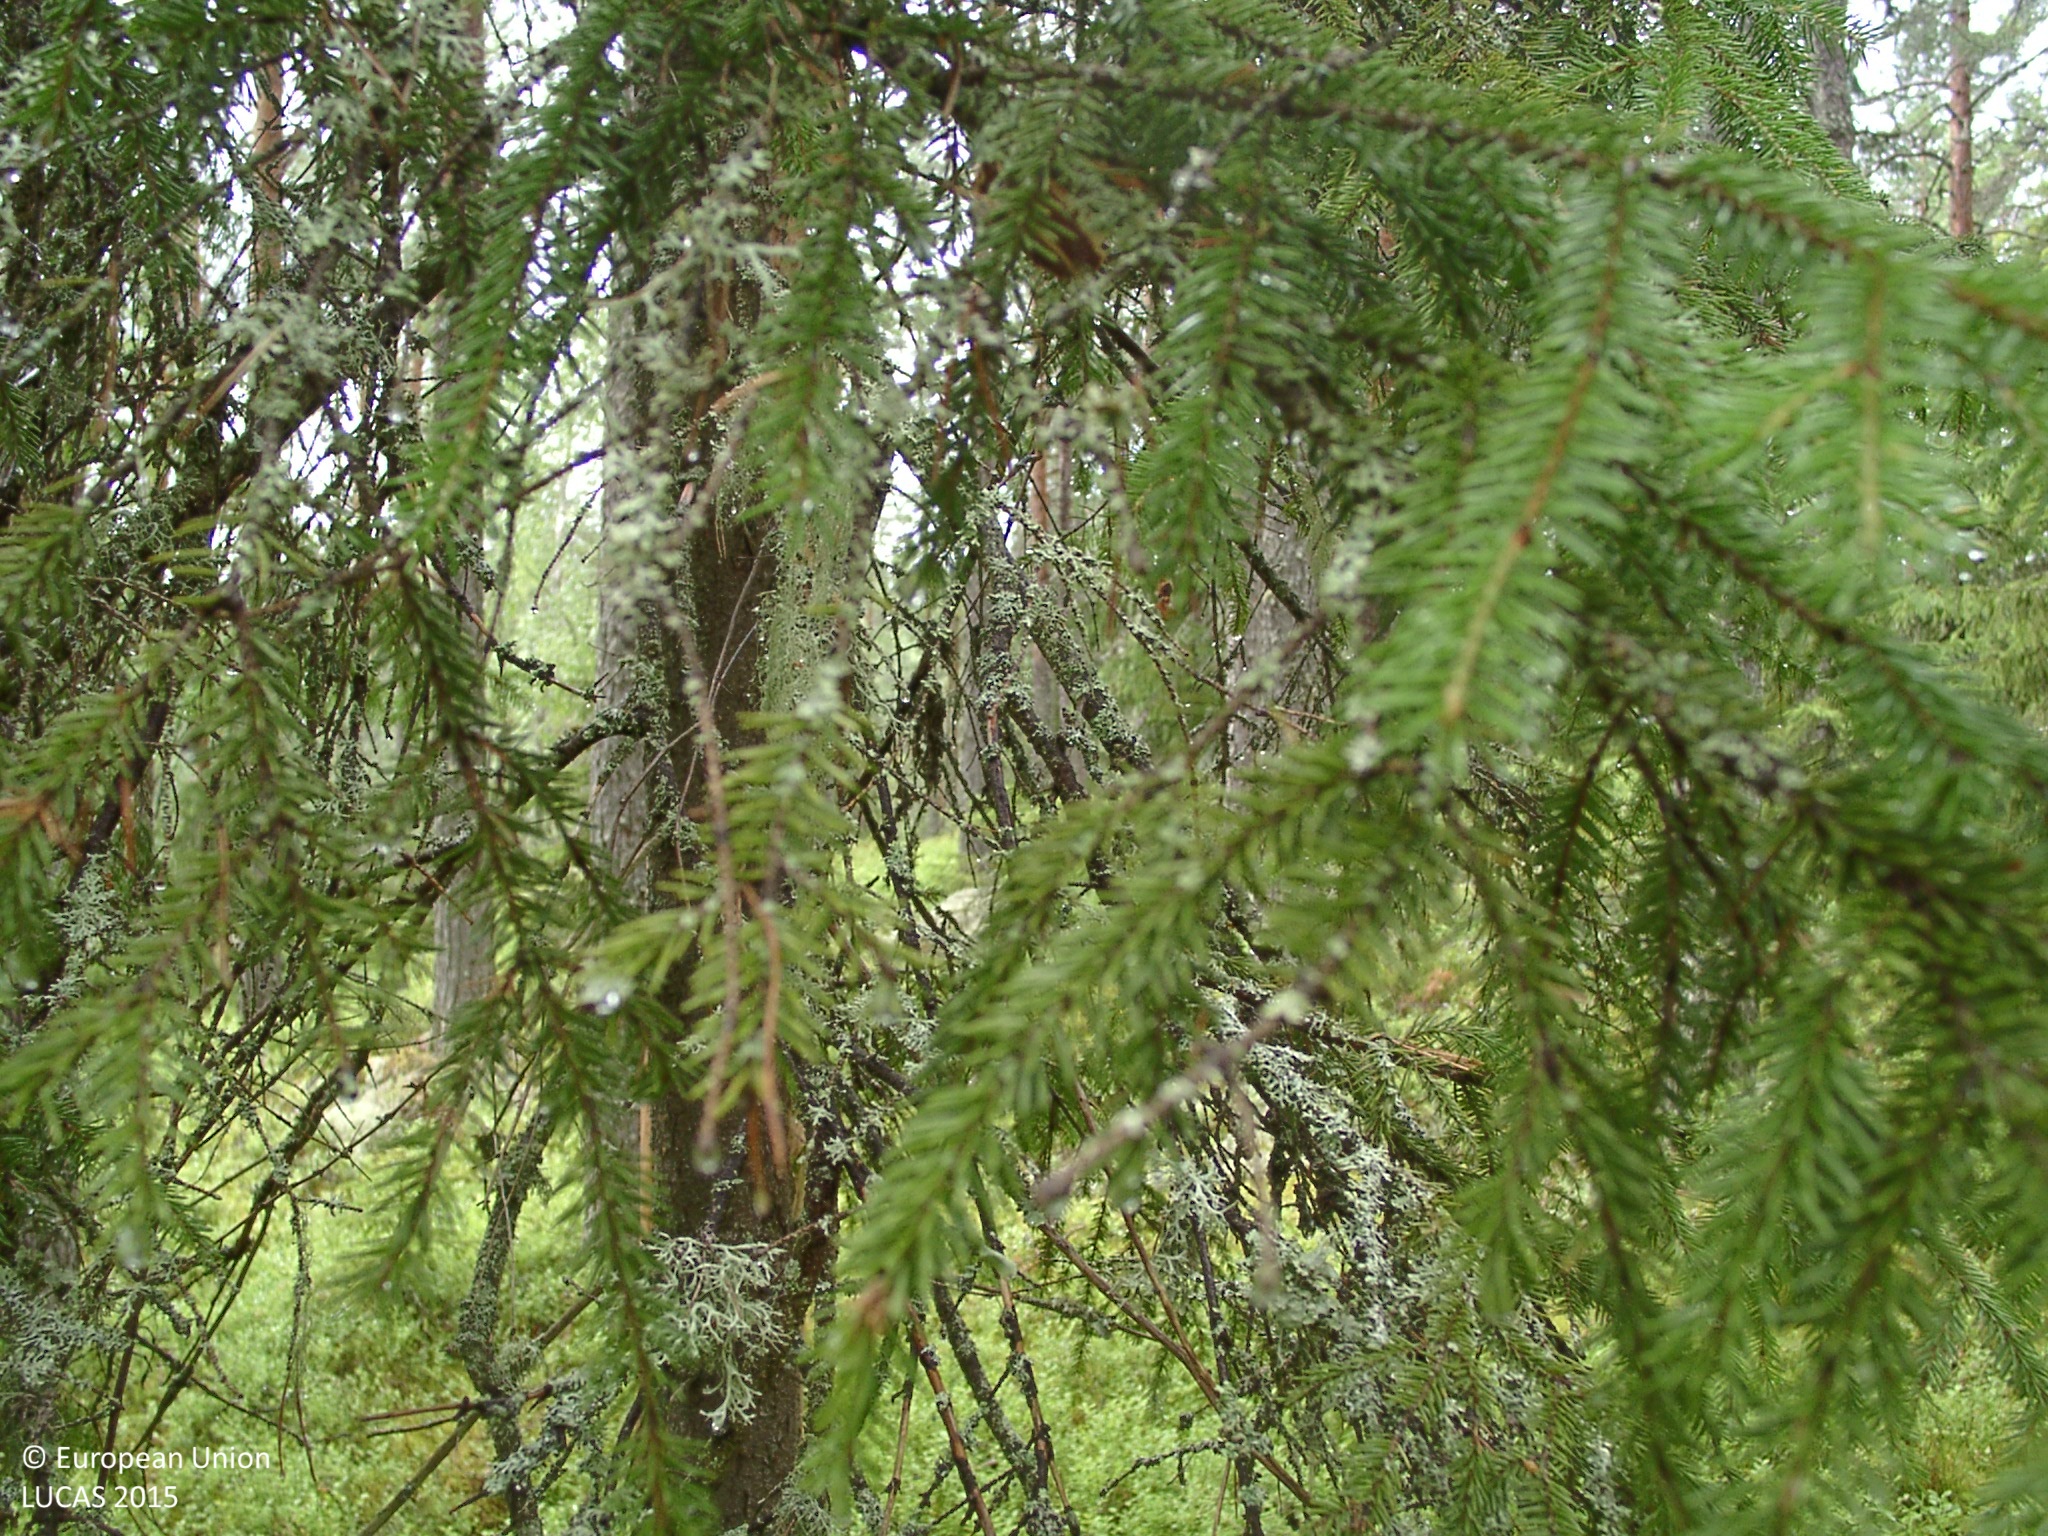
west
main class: Woodland
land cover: Other coniferous woodland
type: boreal forest
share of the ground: 50 - 75 %
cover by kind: coniferous forest trees 55 %, shrubs 25 %, broadleaved forest trees 10 %, lichens and mosses 10 %
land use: Forestry
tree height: > 5 m
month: July
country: FI
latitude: 61.9343
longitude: 25.2974
